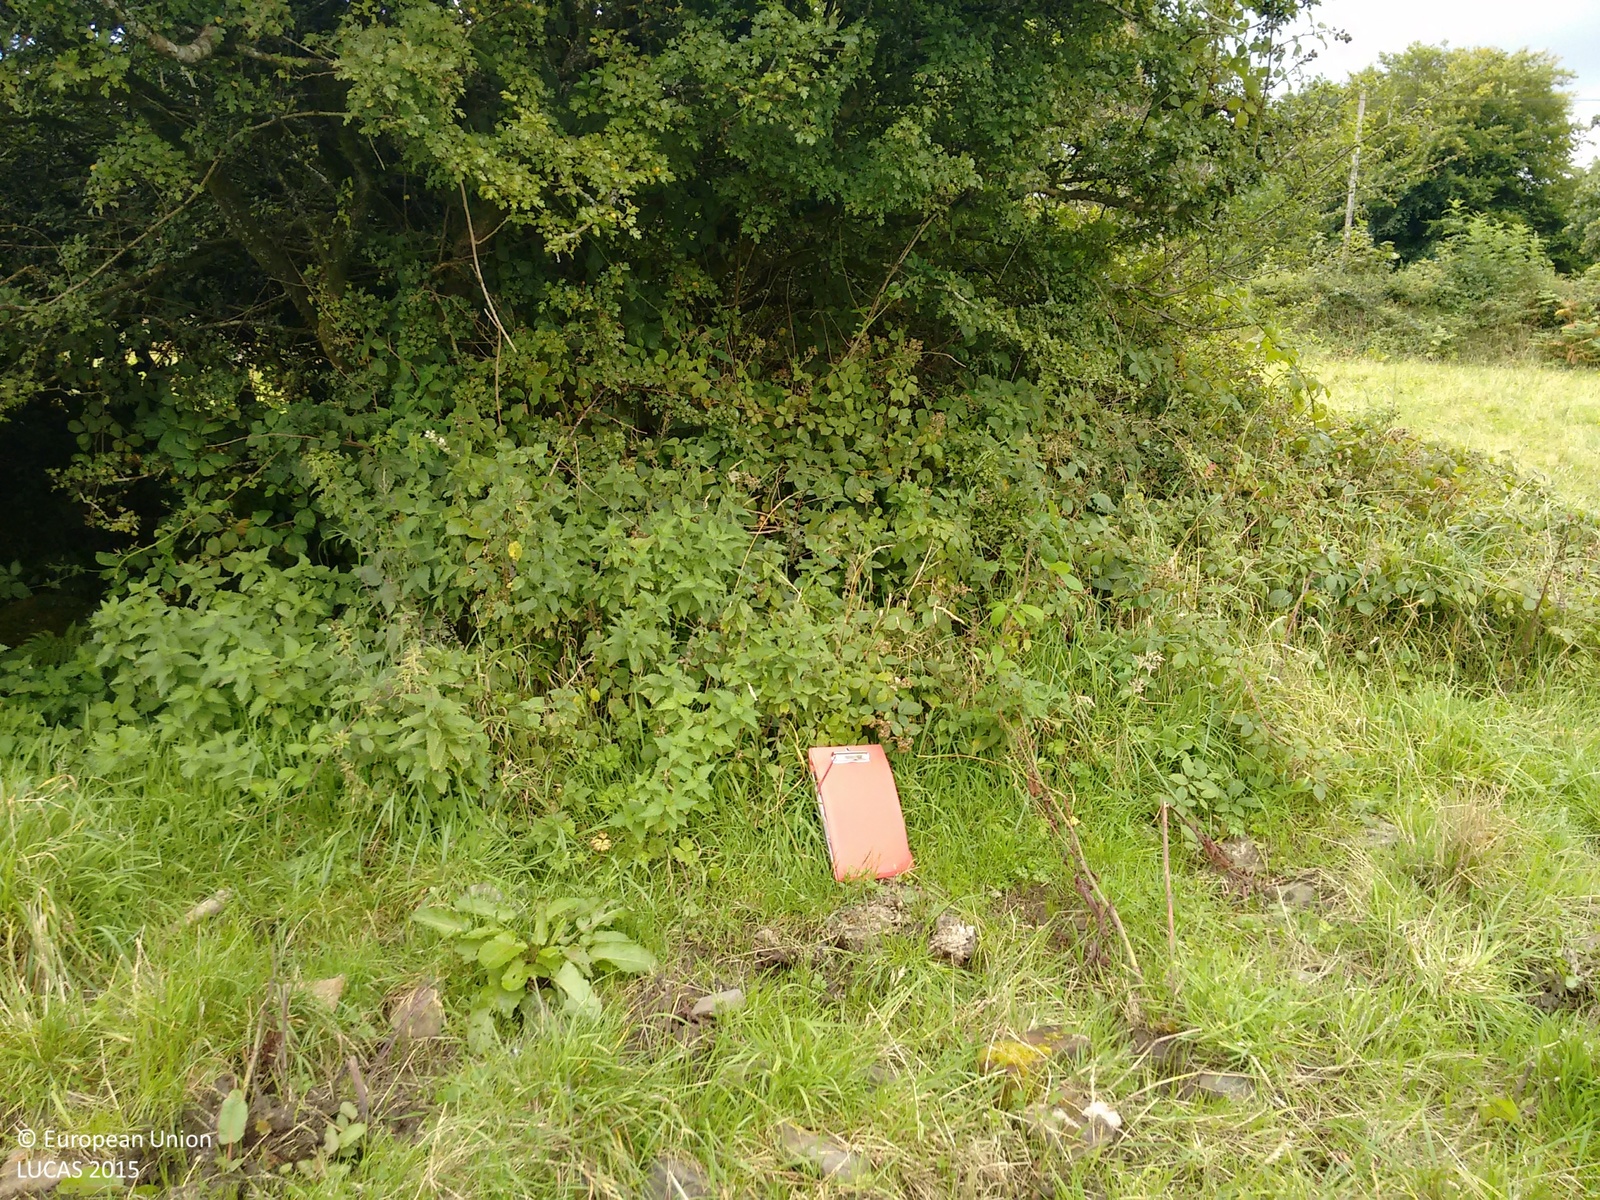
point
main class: Woodland
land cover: Broadleaved woodland
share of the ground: > 75 %
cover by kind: broadleaved forest trees 100 %
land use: Agriculture (excluding fallow land and kitchen gardens)
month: September
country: GB
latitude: 50.6026
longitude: -4.0689
